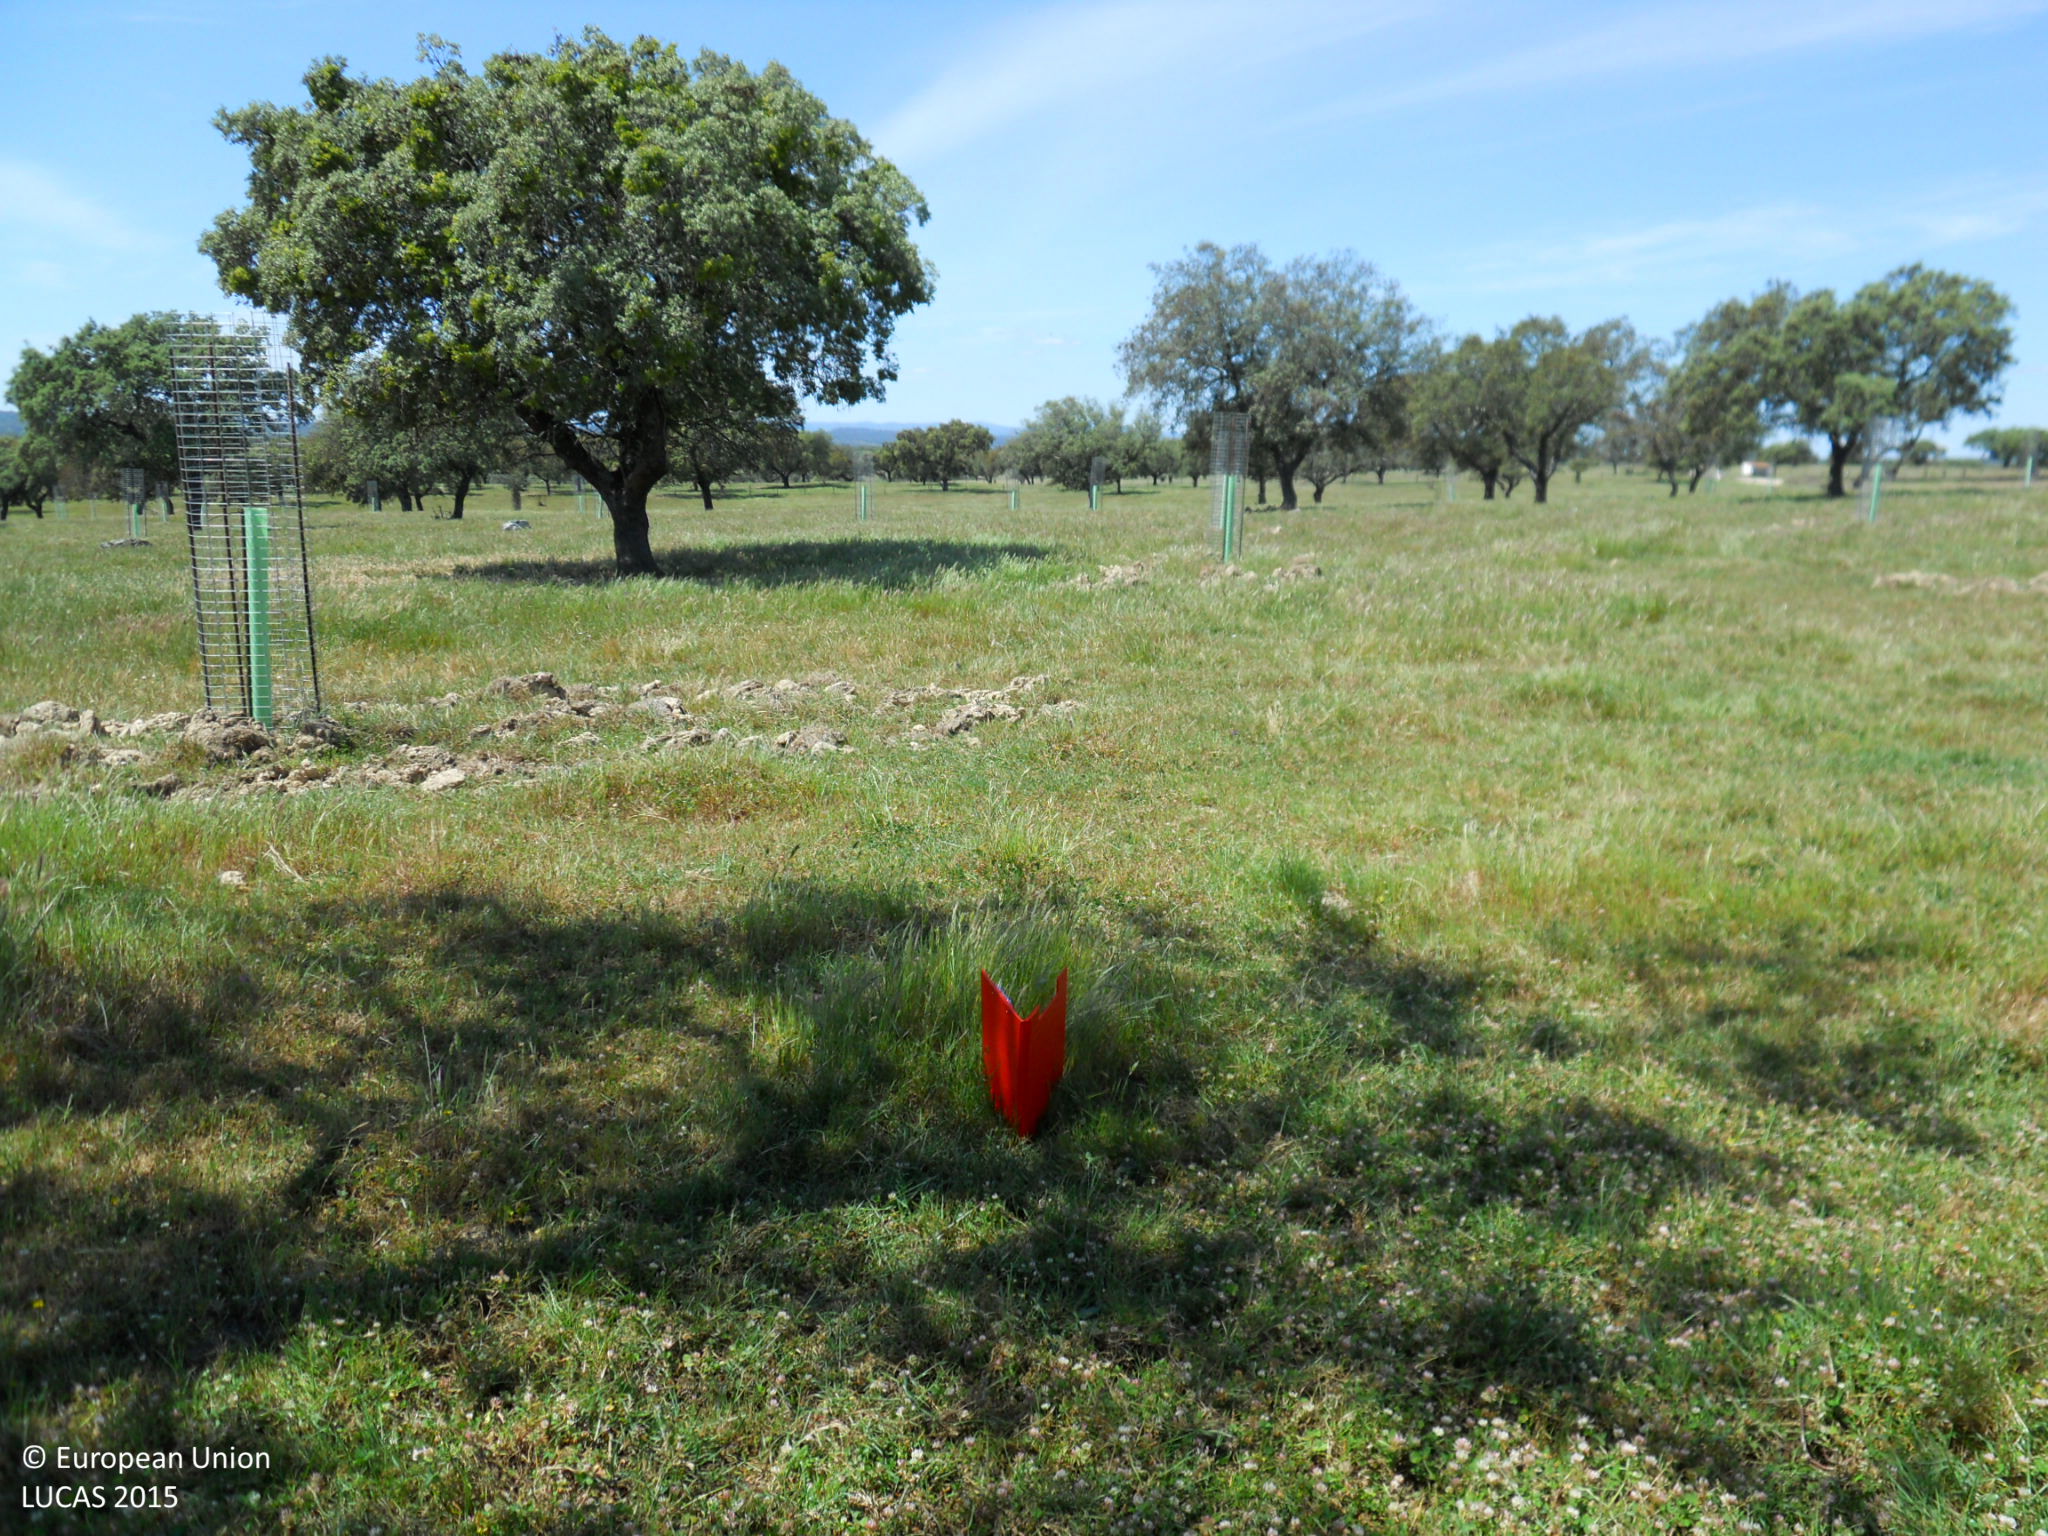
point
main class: Woodland
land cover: Broadleaved woodland
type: broadleaved evergreen forest
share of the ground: 25 - 50 %
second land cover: Grassland without tree/shrub cover
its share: > 75 %
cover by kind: herbaceous plants 65 %, broadleaved forest trees 35 %
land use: Forestry
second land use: Agriculture (excluding fallow land and kitchen gardens)
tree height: > 5 m
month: April
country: ES
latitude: 39.3499
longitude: -6.9621
